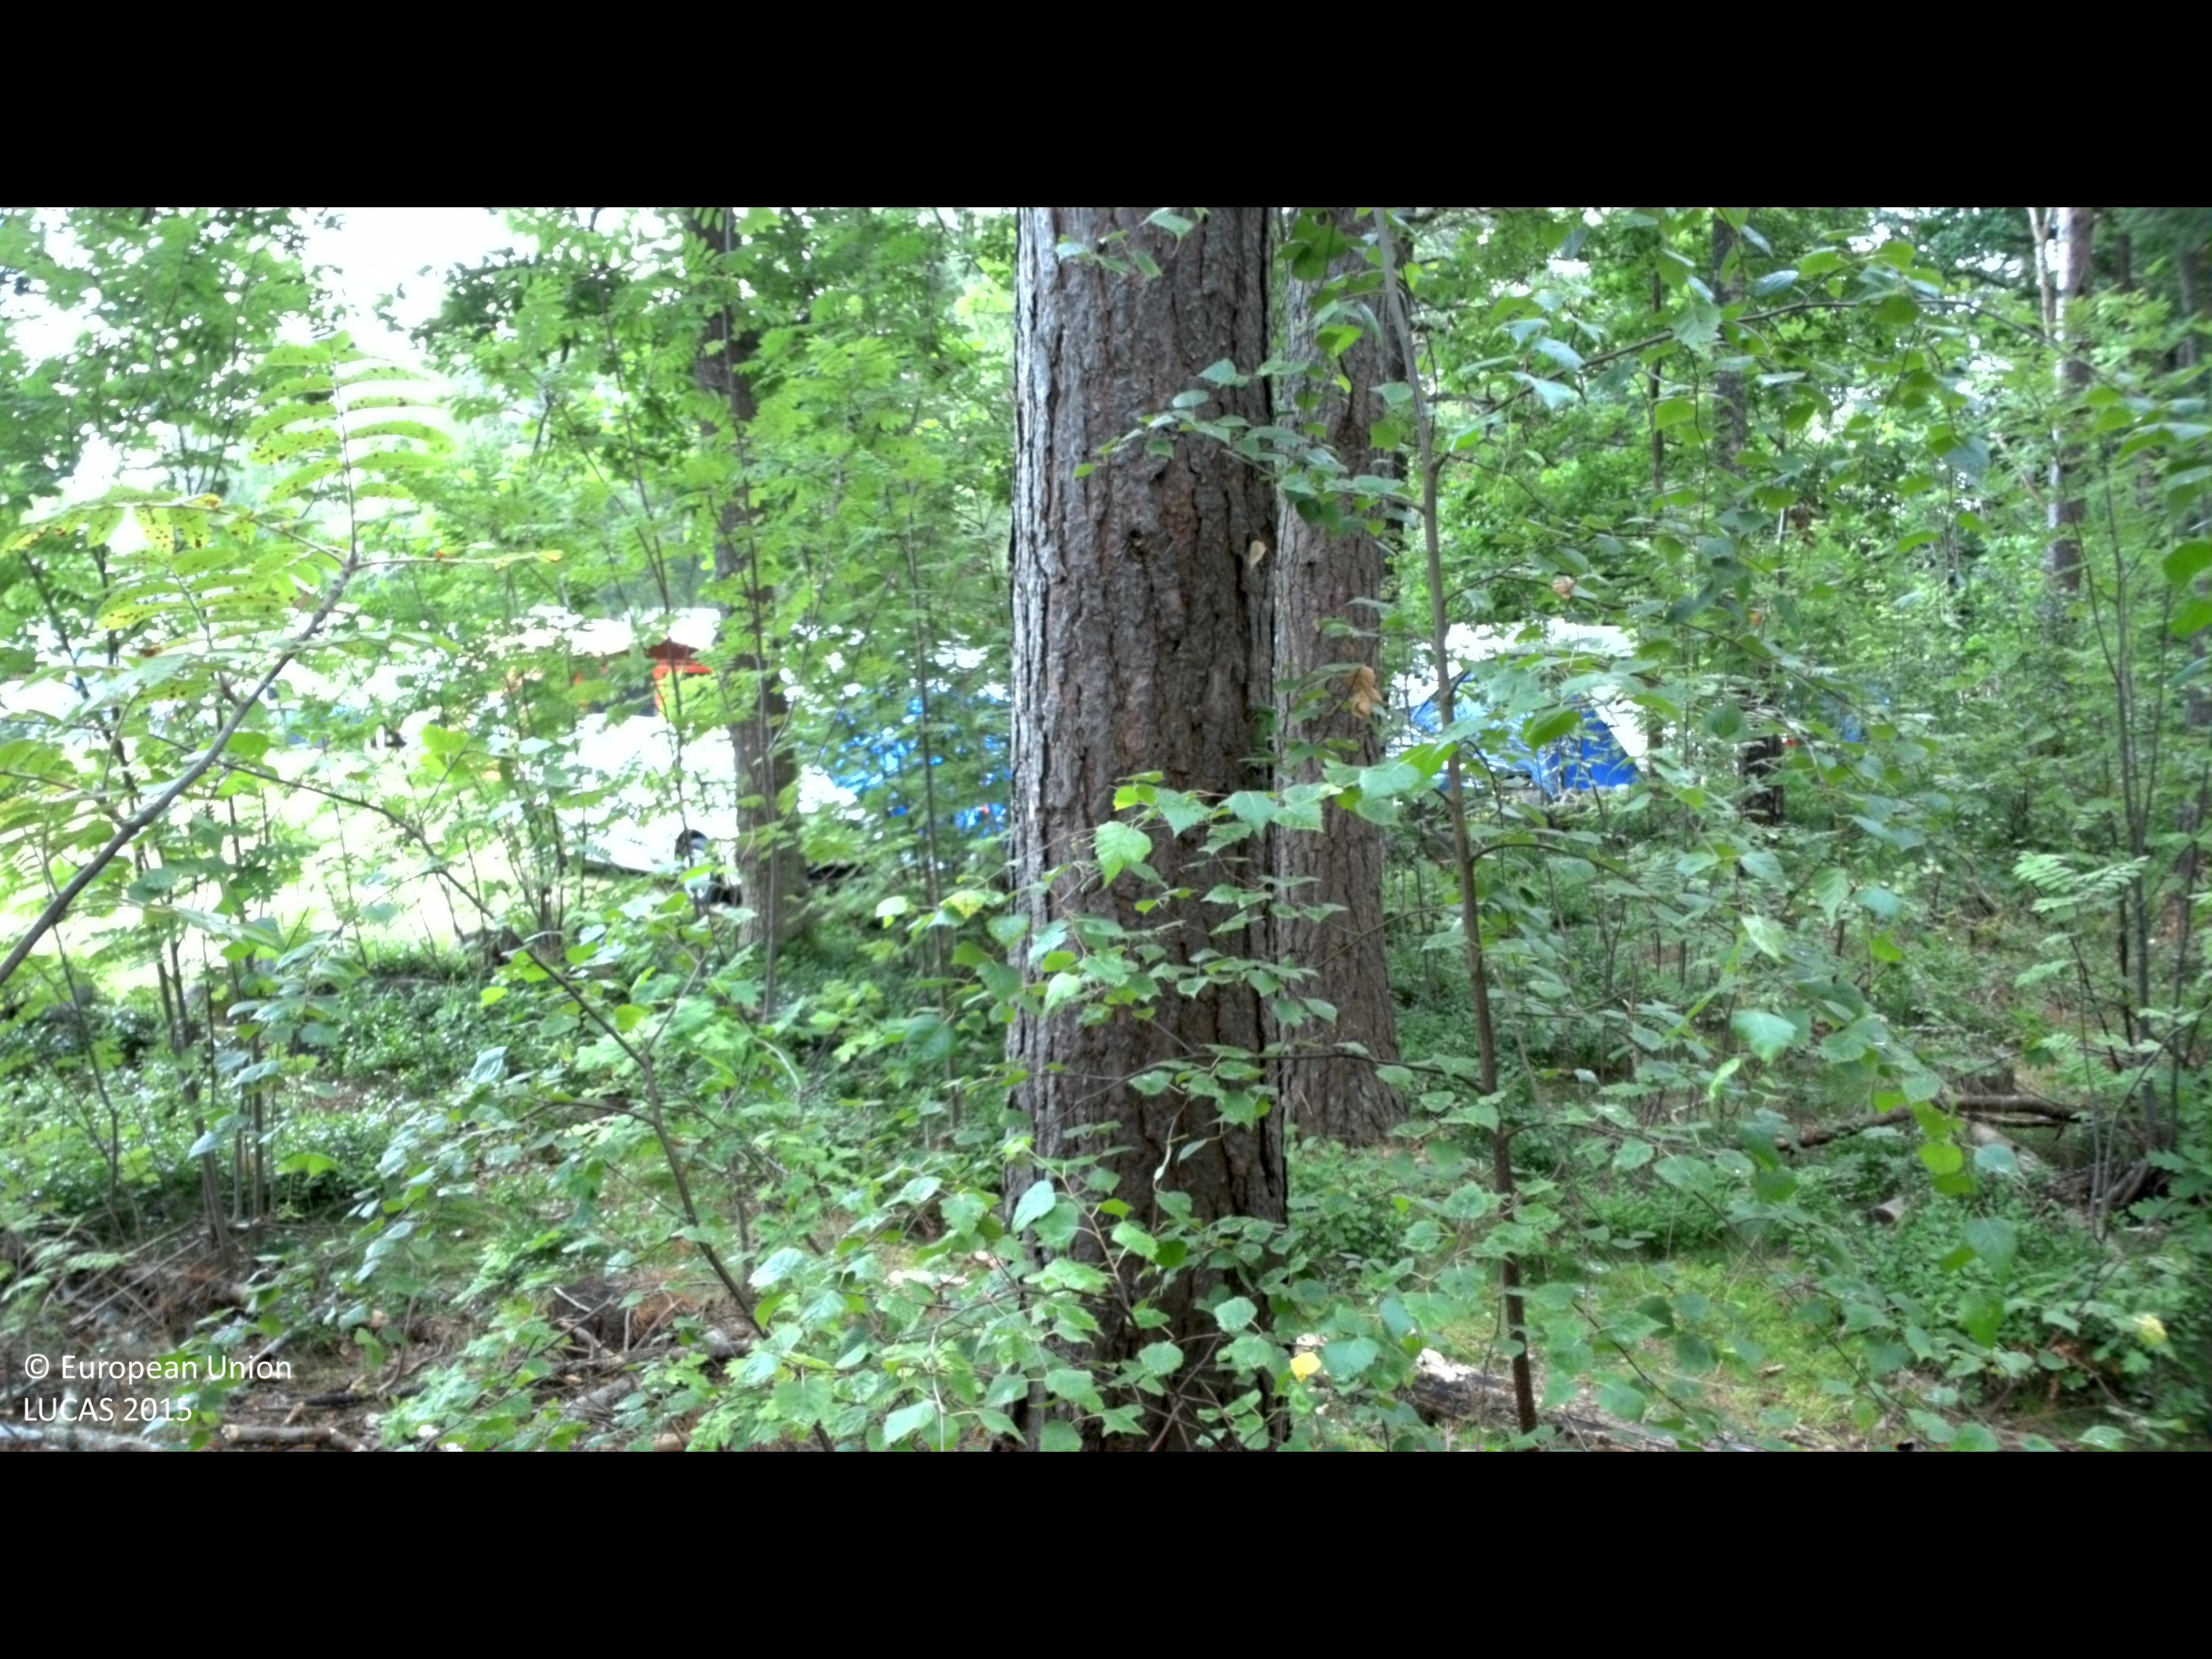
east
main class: Woodland
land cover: Pine dominated coniferous woodland
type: boreal forest
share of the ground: 50 - 75 %
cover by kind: coniferous forest trees 65 %, shrubs 20 %, broadleaved forest trees 10 %, herbaceous plants 5 %
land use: Forestry
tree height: > 5 m
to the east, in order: Pine dominated coniferous woodland; Dry stone walls; Artificial constructions in urban areas; Broadleaved woodland
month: July
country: SE
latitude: 57.2579
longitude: 17.0473
